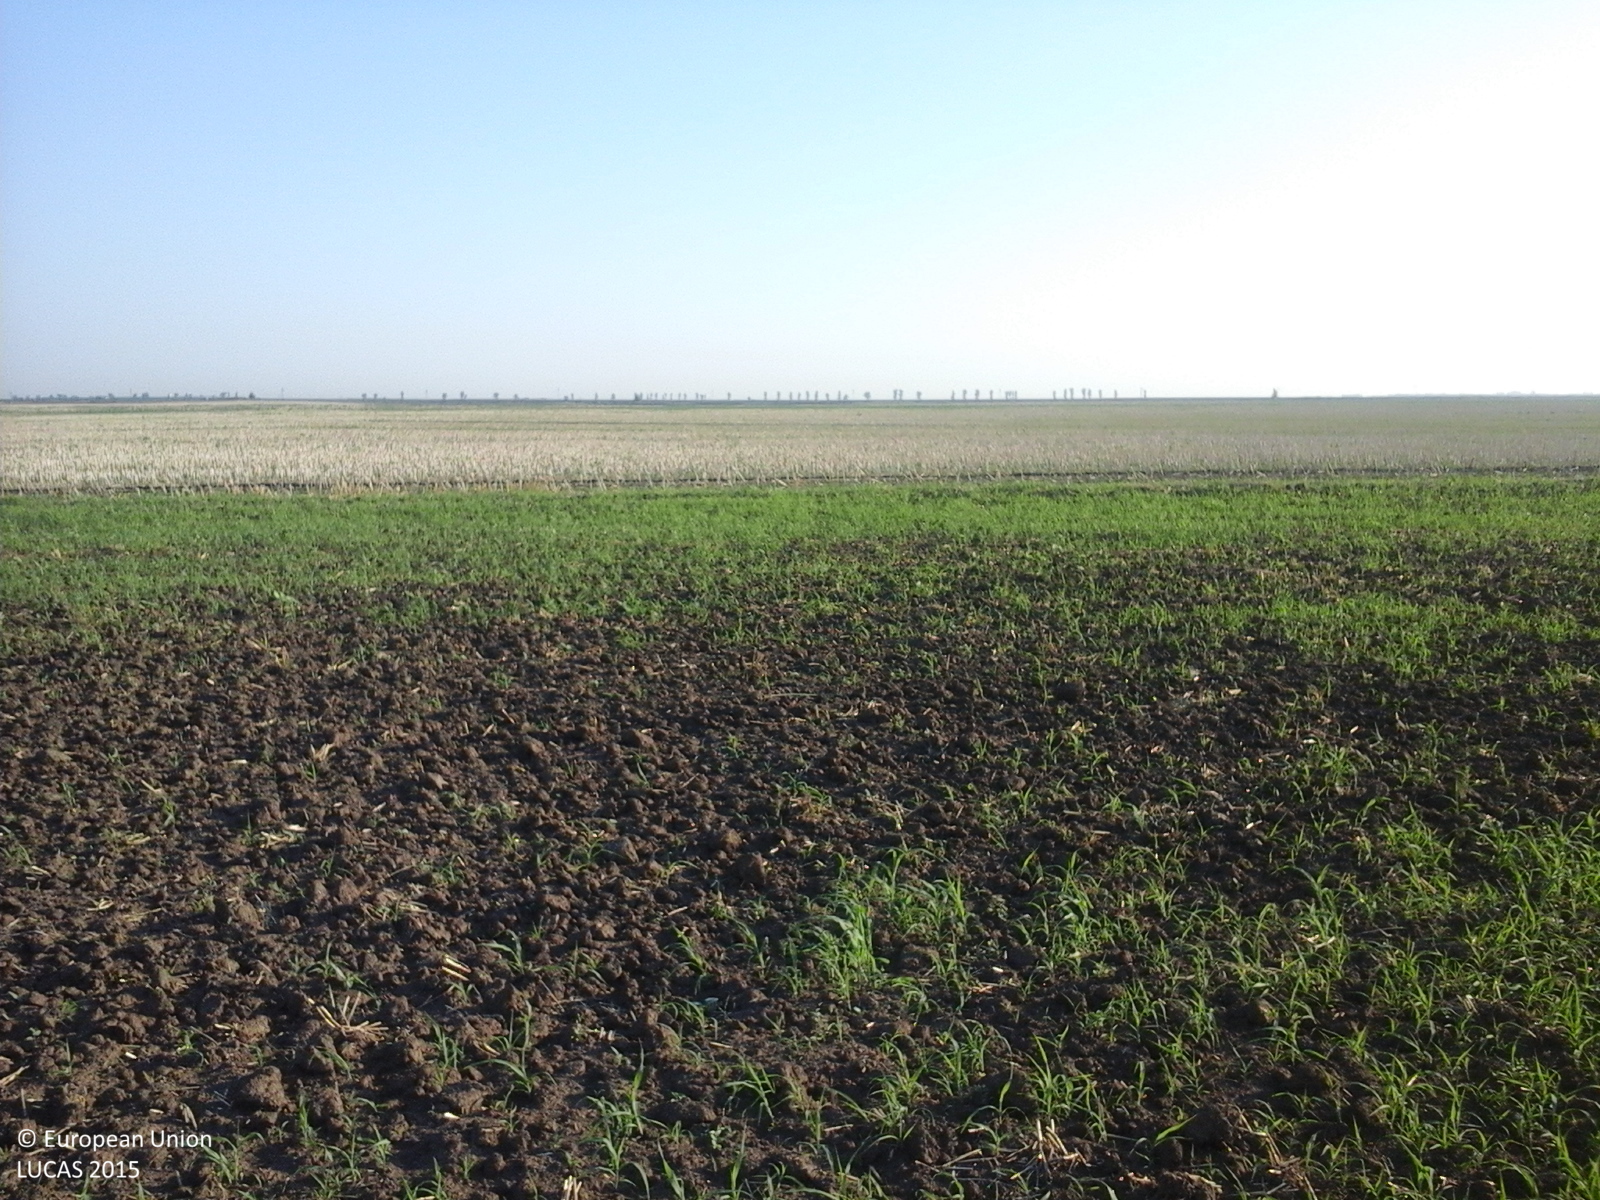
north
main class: Cropland
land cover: Common wheat
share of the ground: 25 - 50 %
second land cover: Spontaneously vegetated surfaces
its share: 10 - 25 %
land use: Agriculture (excluding fallow land and kitchen gardens)
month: July
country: RO
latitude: 44.3909
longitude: 27.4258
